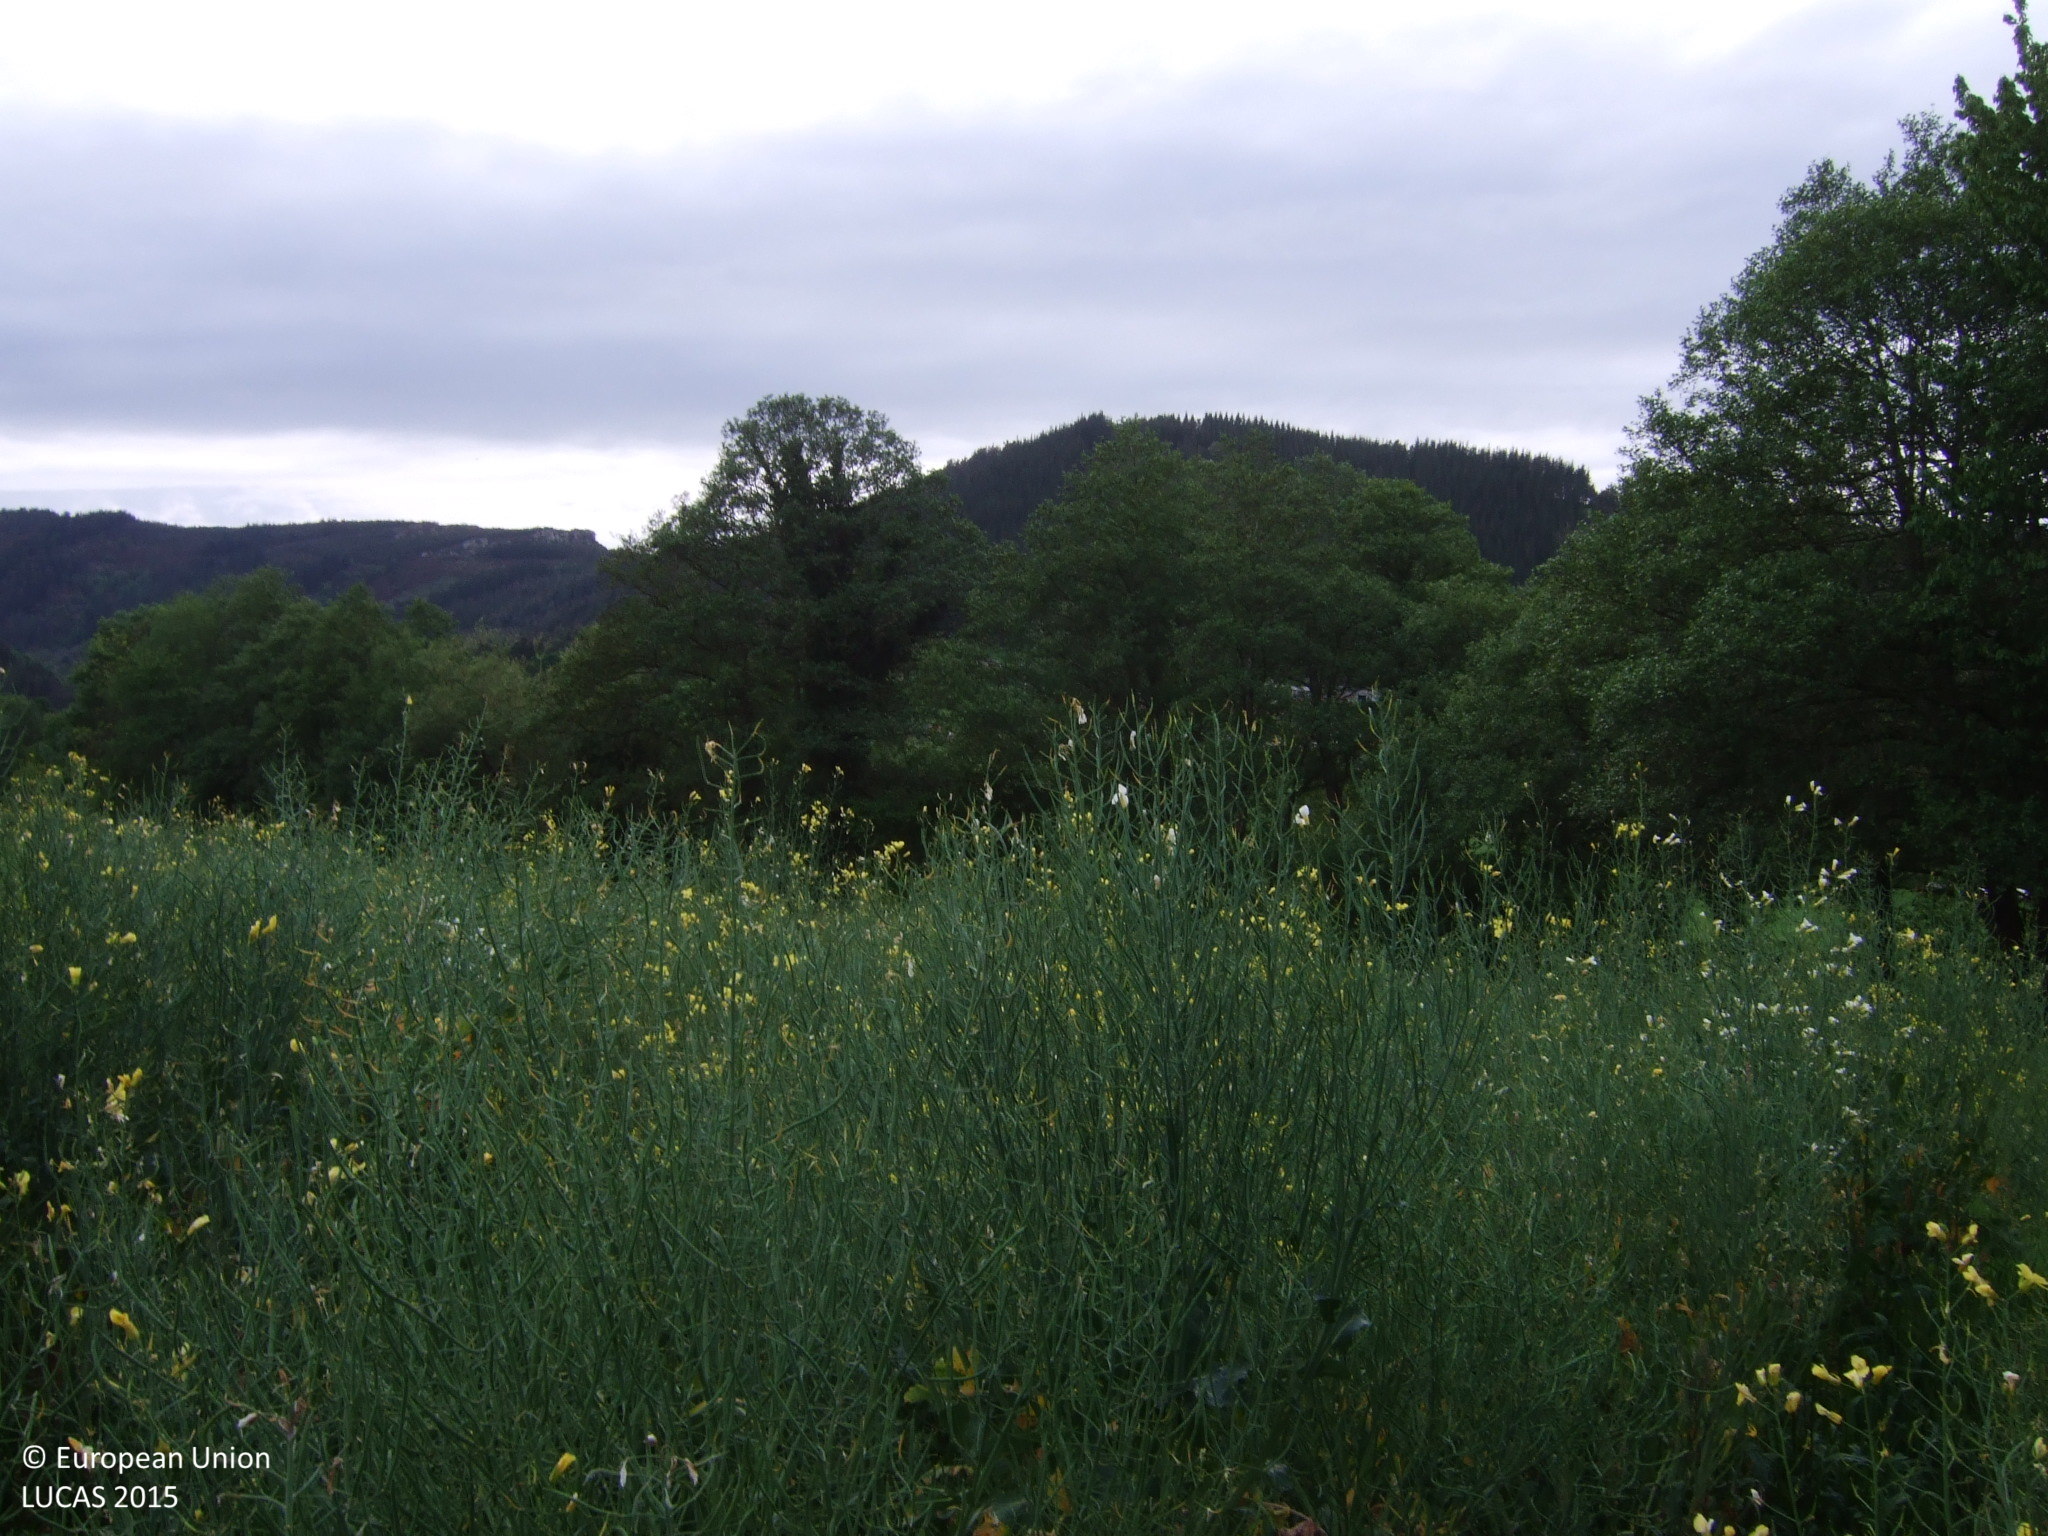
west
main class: Cropland
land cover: Other fresh vegetables
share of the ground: 50 - 75 %
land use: Agriculture (excluding fallow land and kitchen gardens)
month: May
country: ES
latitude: 43.1587
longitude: -7.2010
